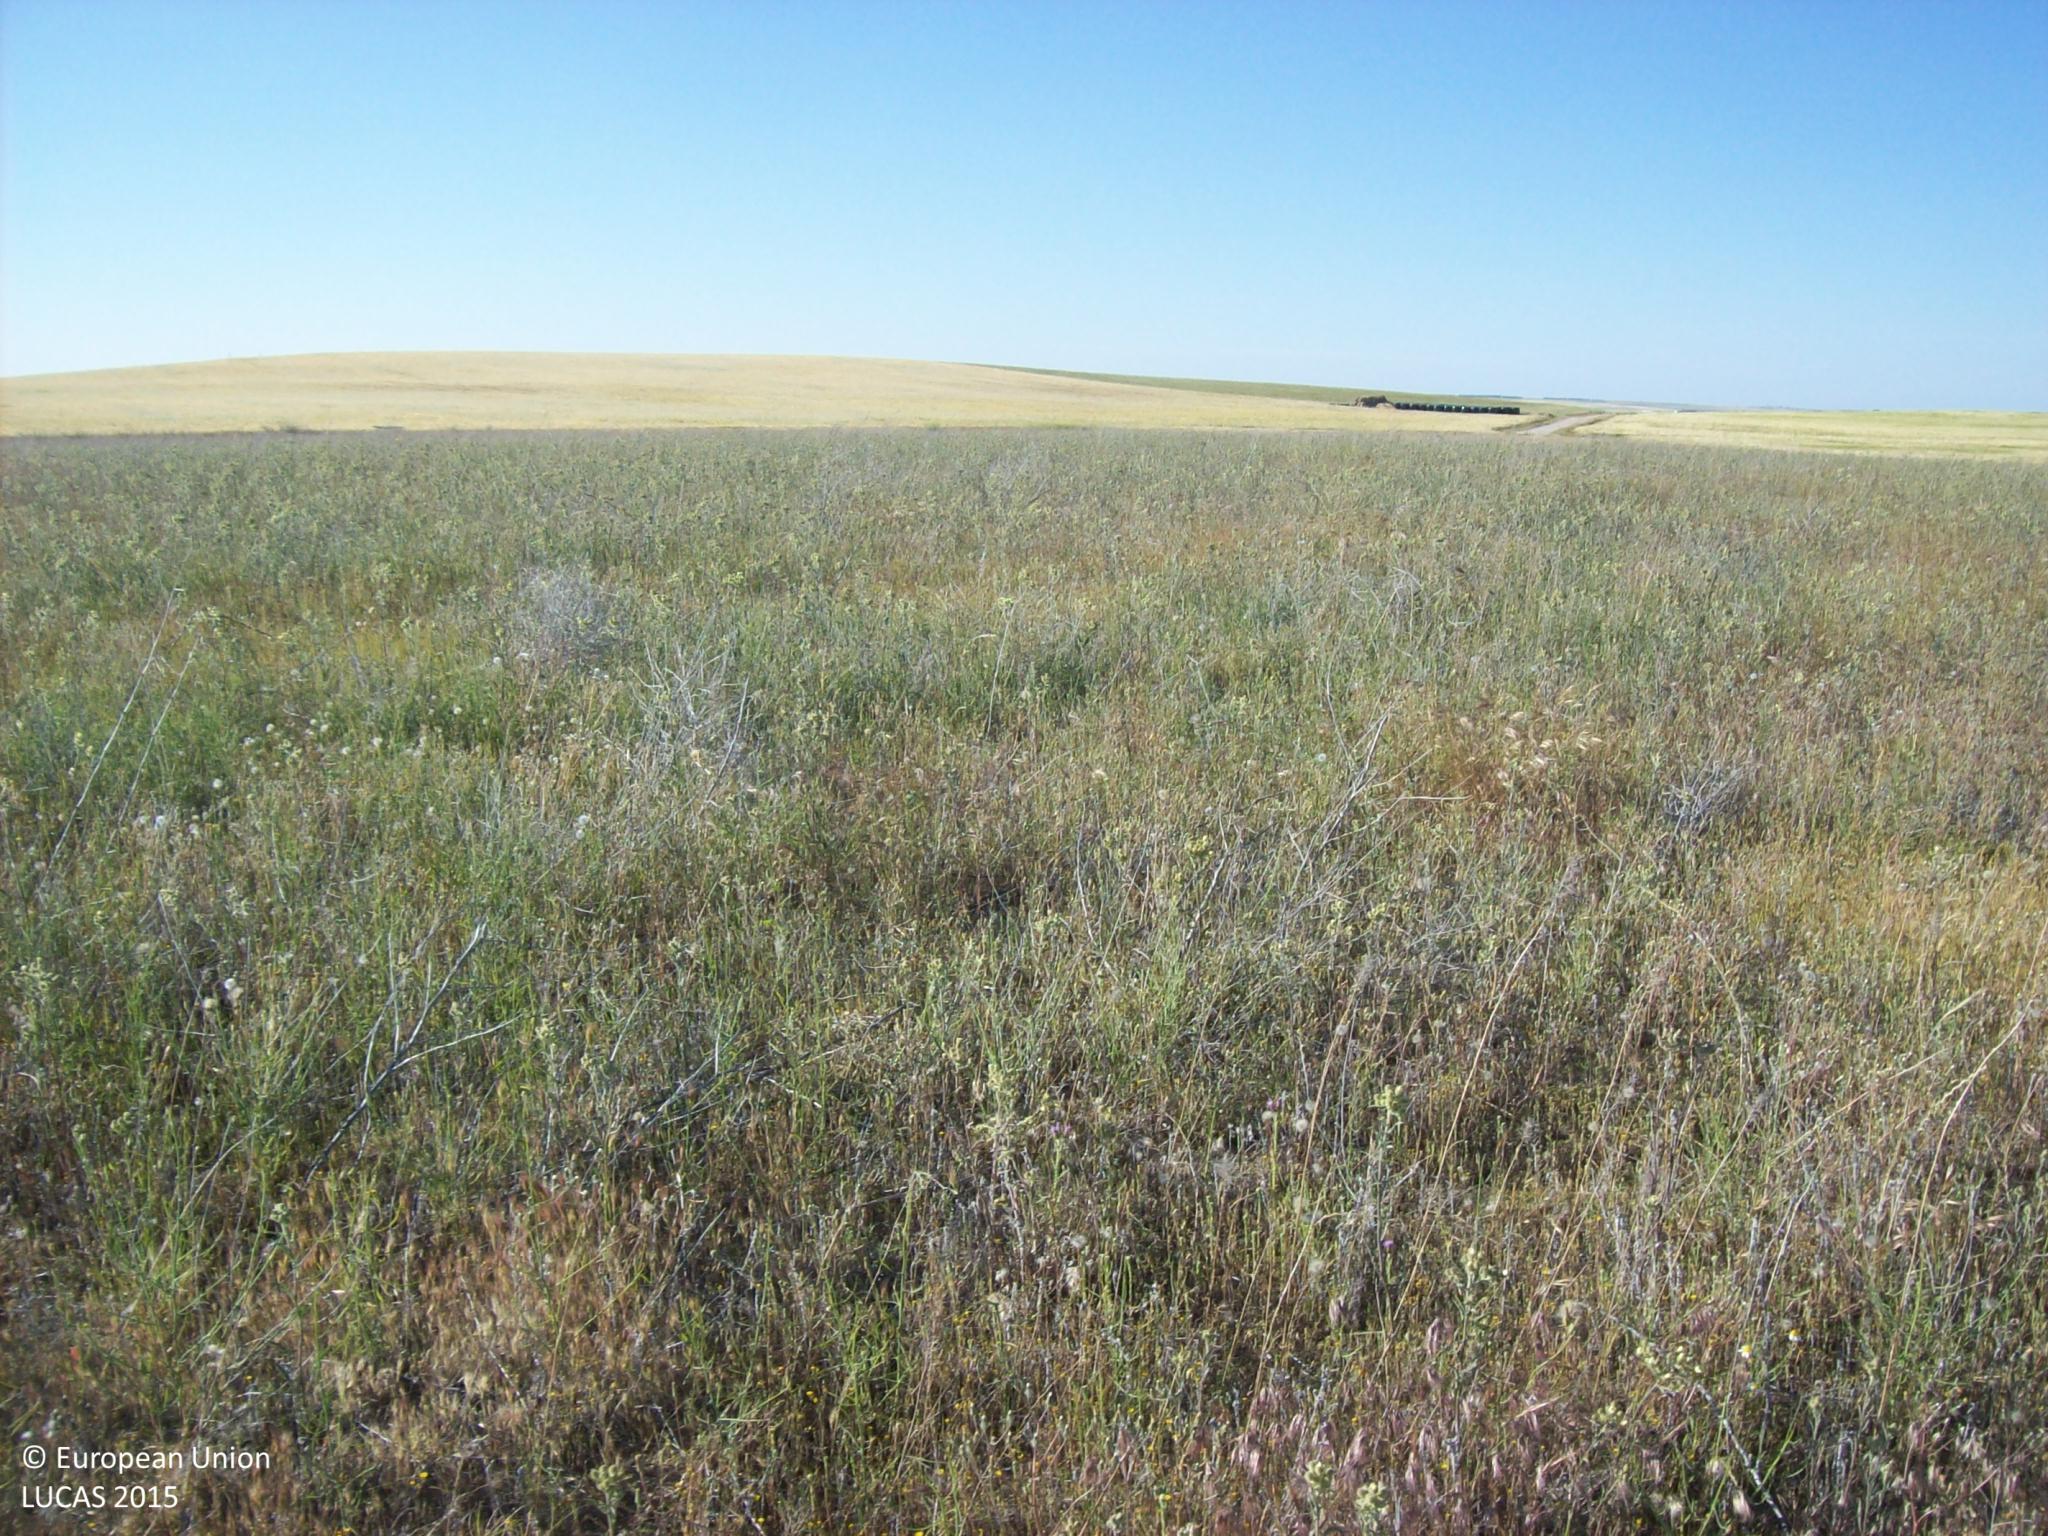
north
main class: Grassland
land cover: Spontaneously vegetated surfaces
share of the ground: > 75 %
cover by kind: herbaceous plants 100 %
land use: Abandoned areas
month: May
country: ES
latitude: 40.7912
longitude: -4.9105
